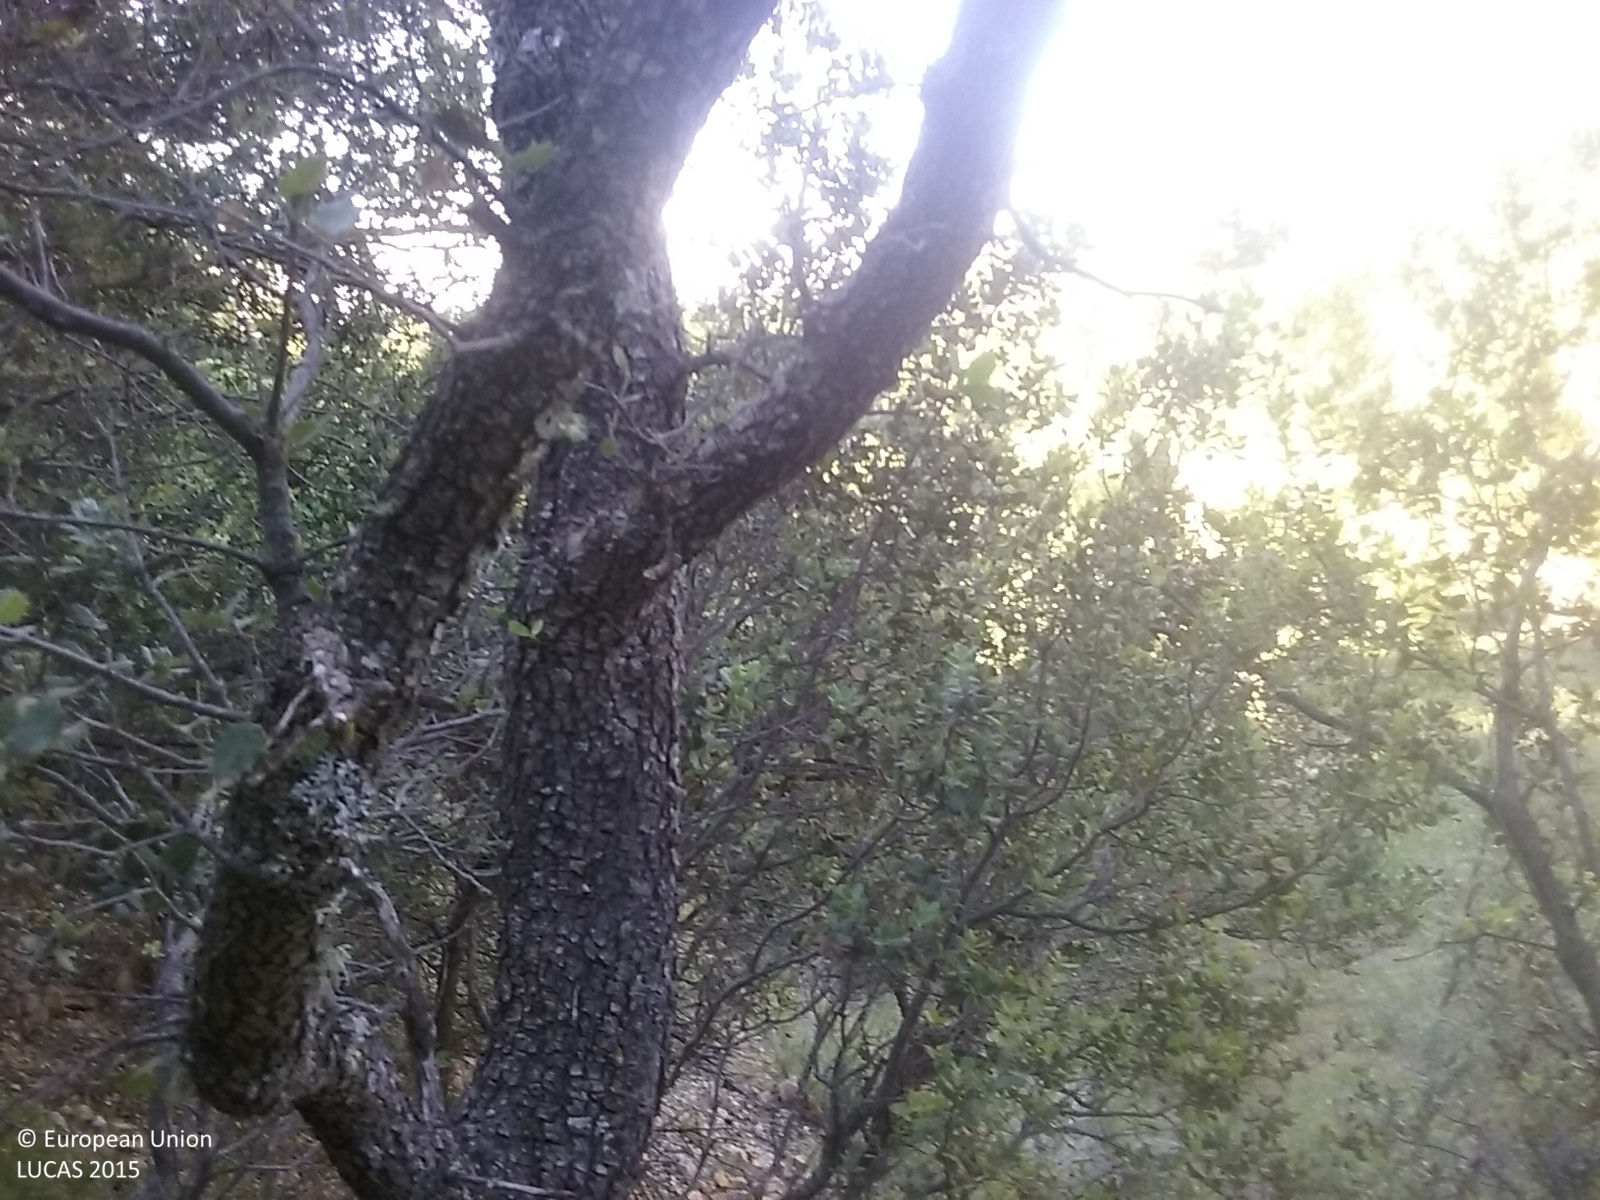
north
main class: Woodland
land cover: Pine dominated mixed woodland
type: coniferous forest of the mediterranean region
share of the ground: > 75 %
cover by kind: coniferous forest trees 50 %, broadleaved forest trees 40 %, shrubs 10 %
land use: Semi-natural and natural areas not in use
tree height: > 5 m
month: June
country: ES
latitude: 40.7301
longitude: -0.0843
